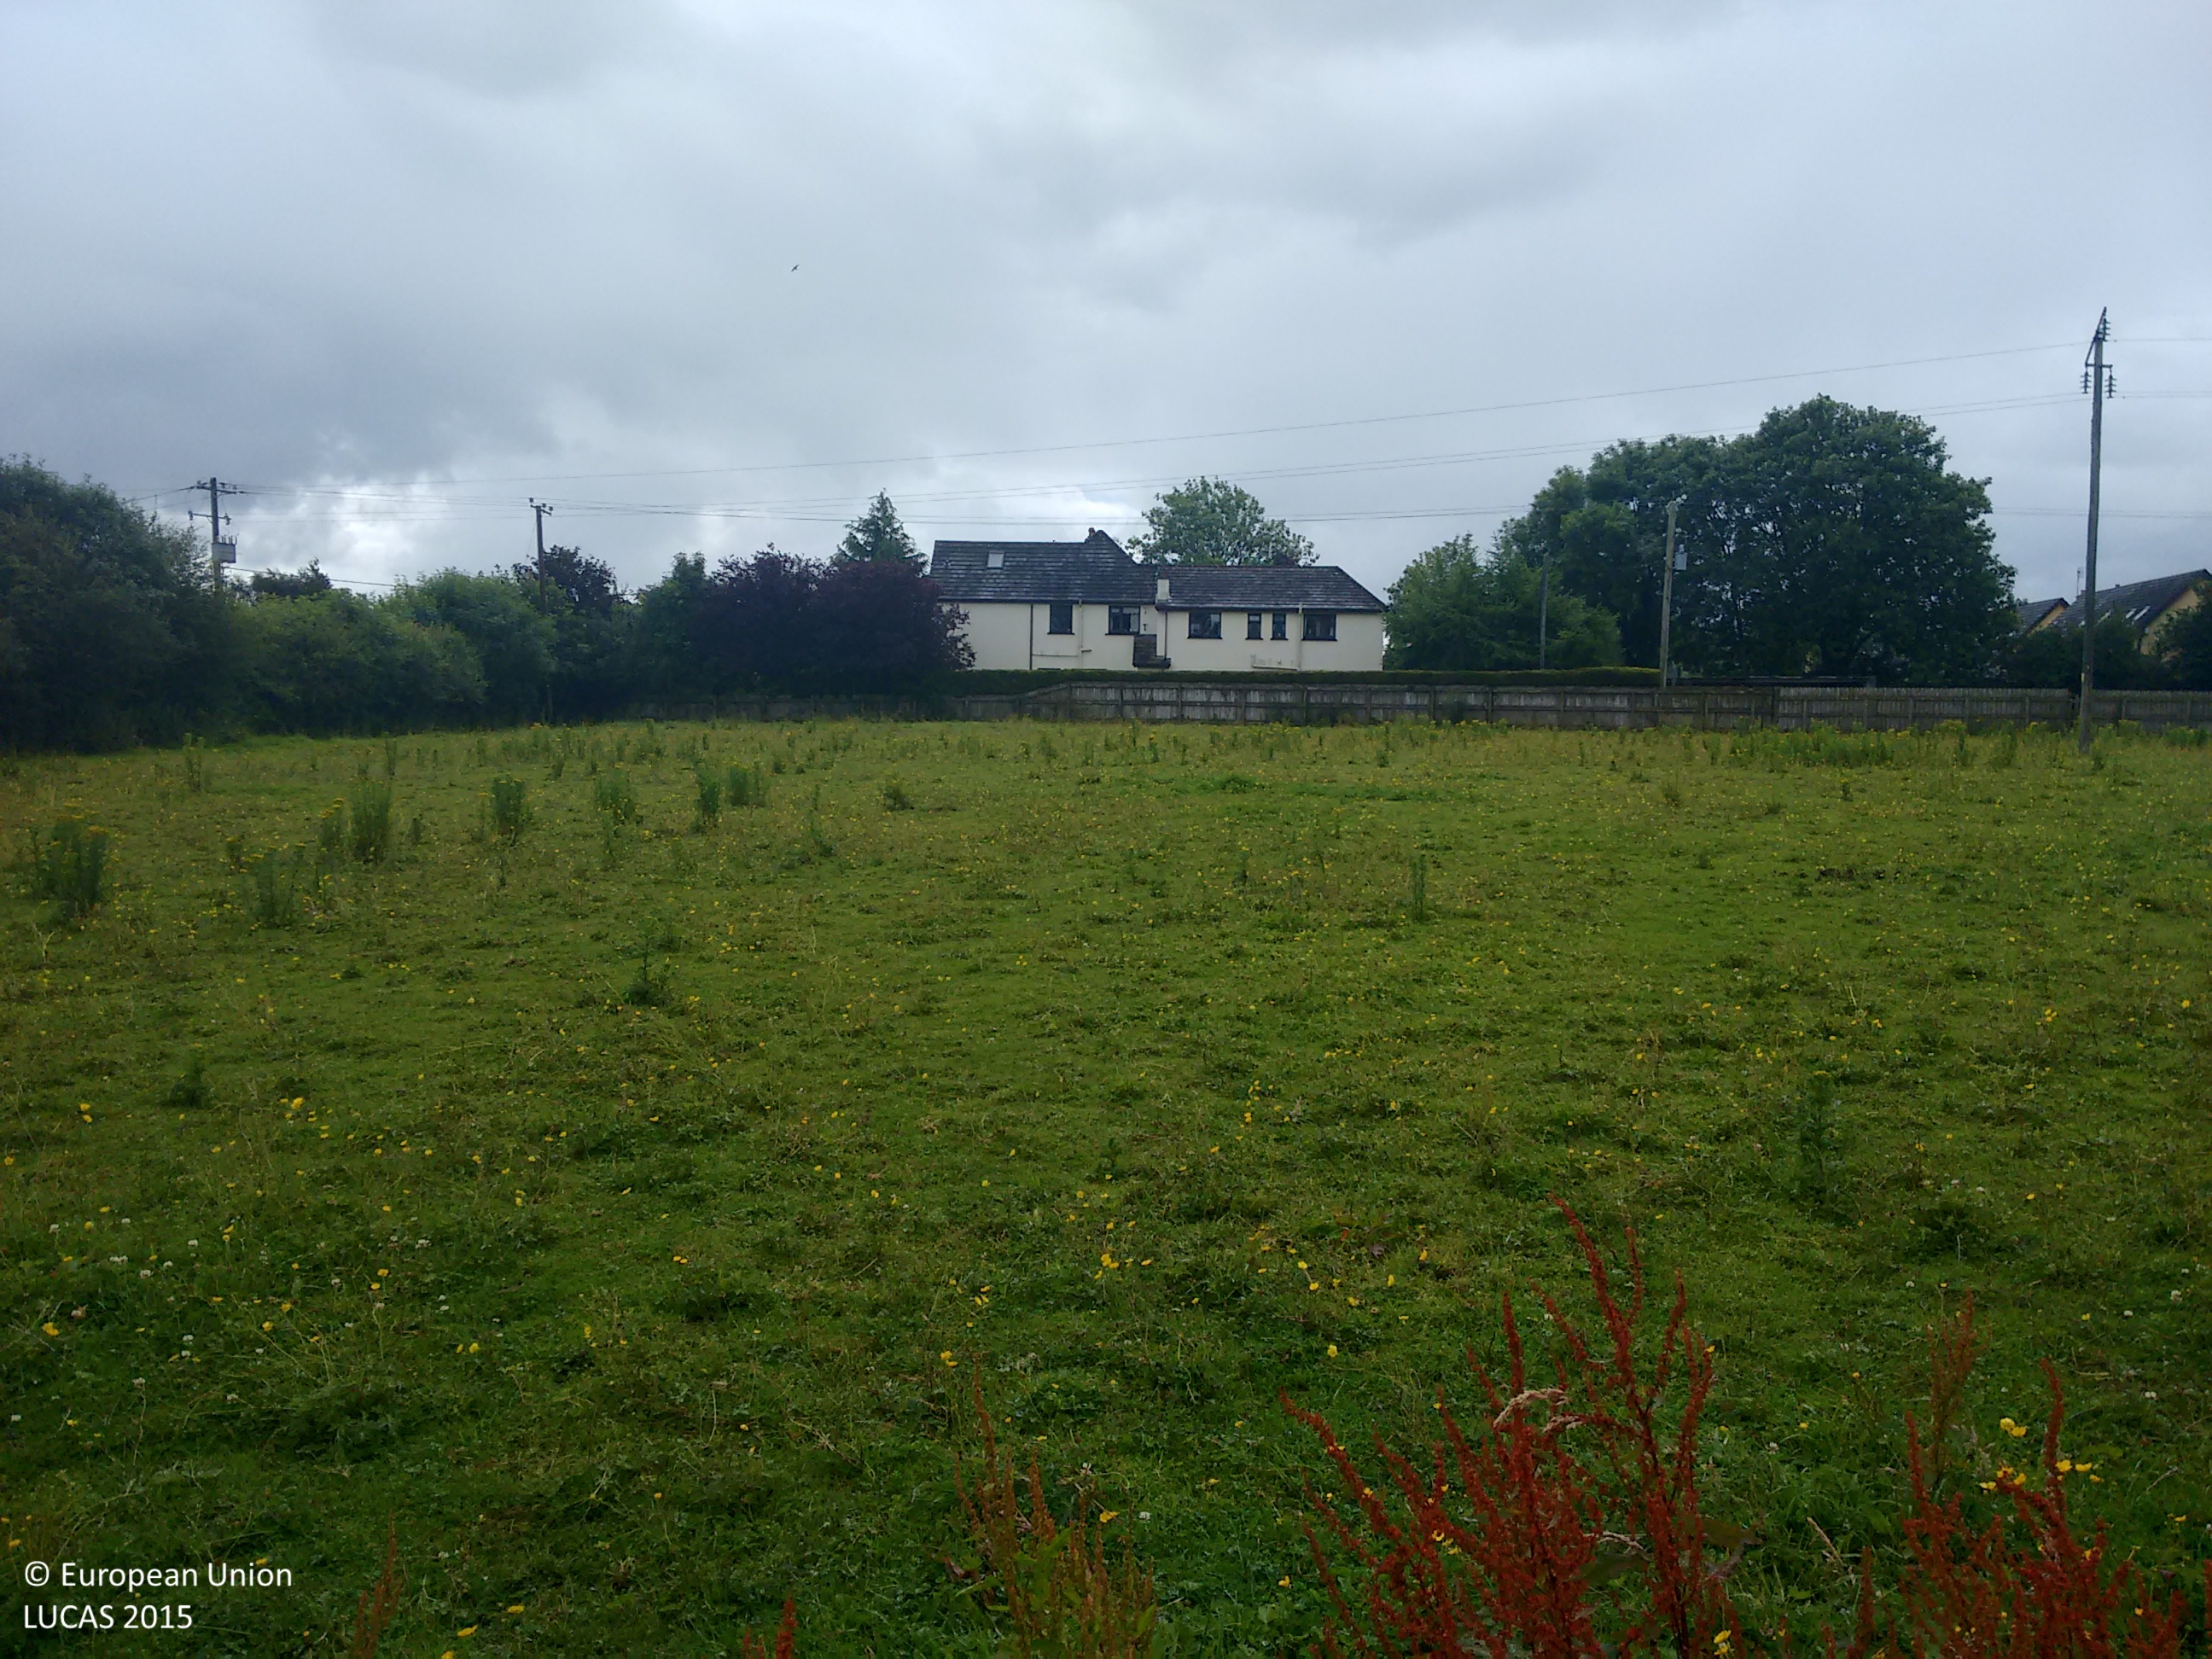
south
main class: Grassland
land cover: Grassland without tree/shrub cover
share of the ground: > 75 %
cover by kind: herbaceous plants 100 %
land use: Agriculture (excluding fallow land and kitchen gardens)
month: July
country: IE
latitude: 53.7454
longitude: -7.8026
